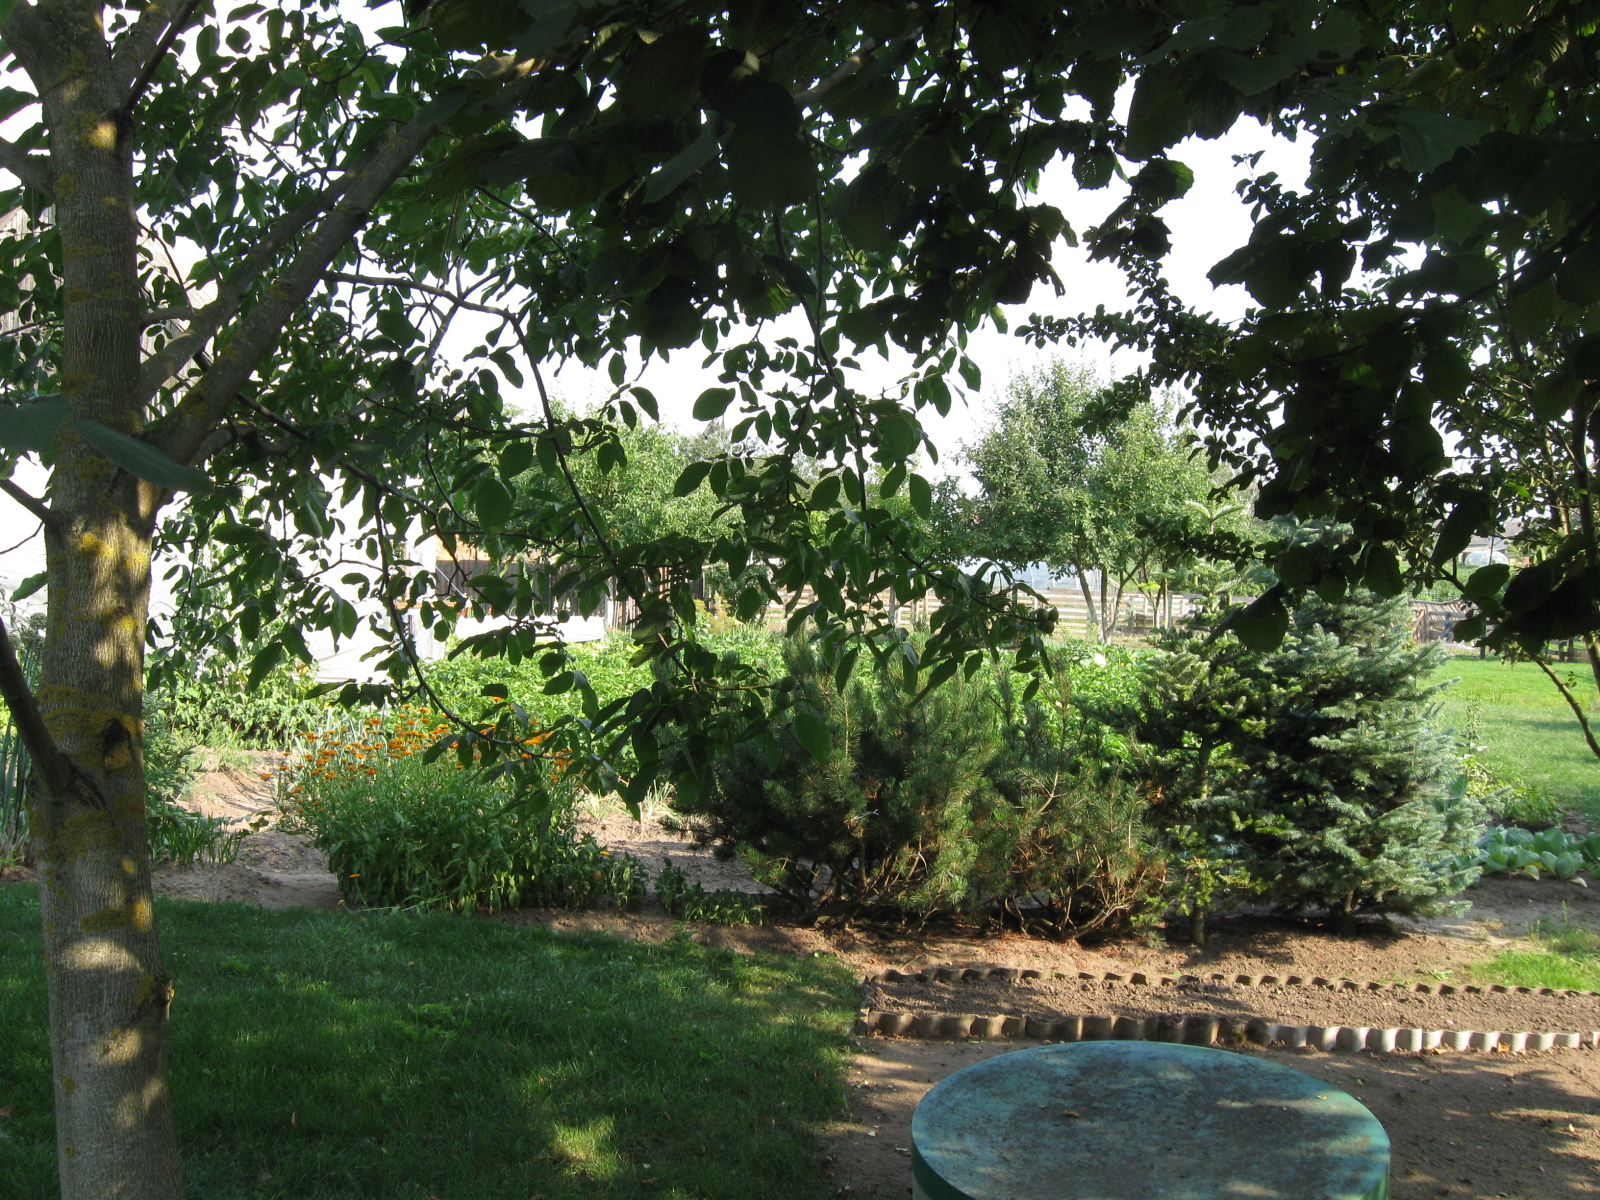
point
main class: Cropland
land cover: Apple fruit
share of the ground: 10 - 25 %
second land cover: Grassland without tree/shrub cover
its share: > 75 %
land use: Kitchen garden
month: August
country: LT
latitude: 54.4374
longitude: 23.2597
